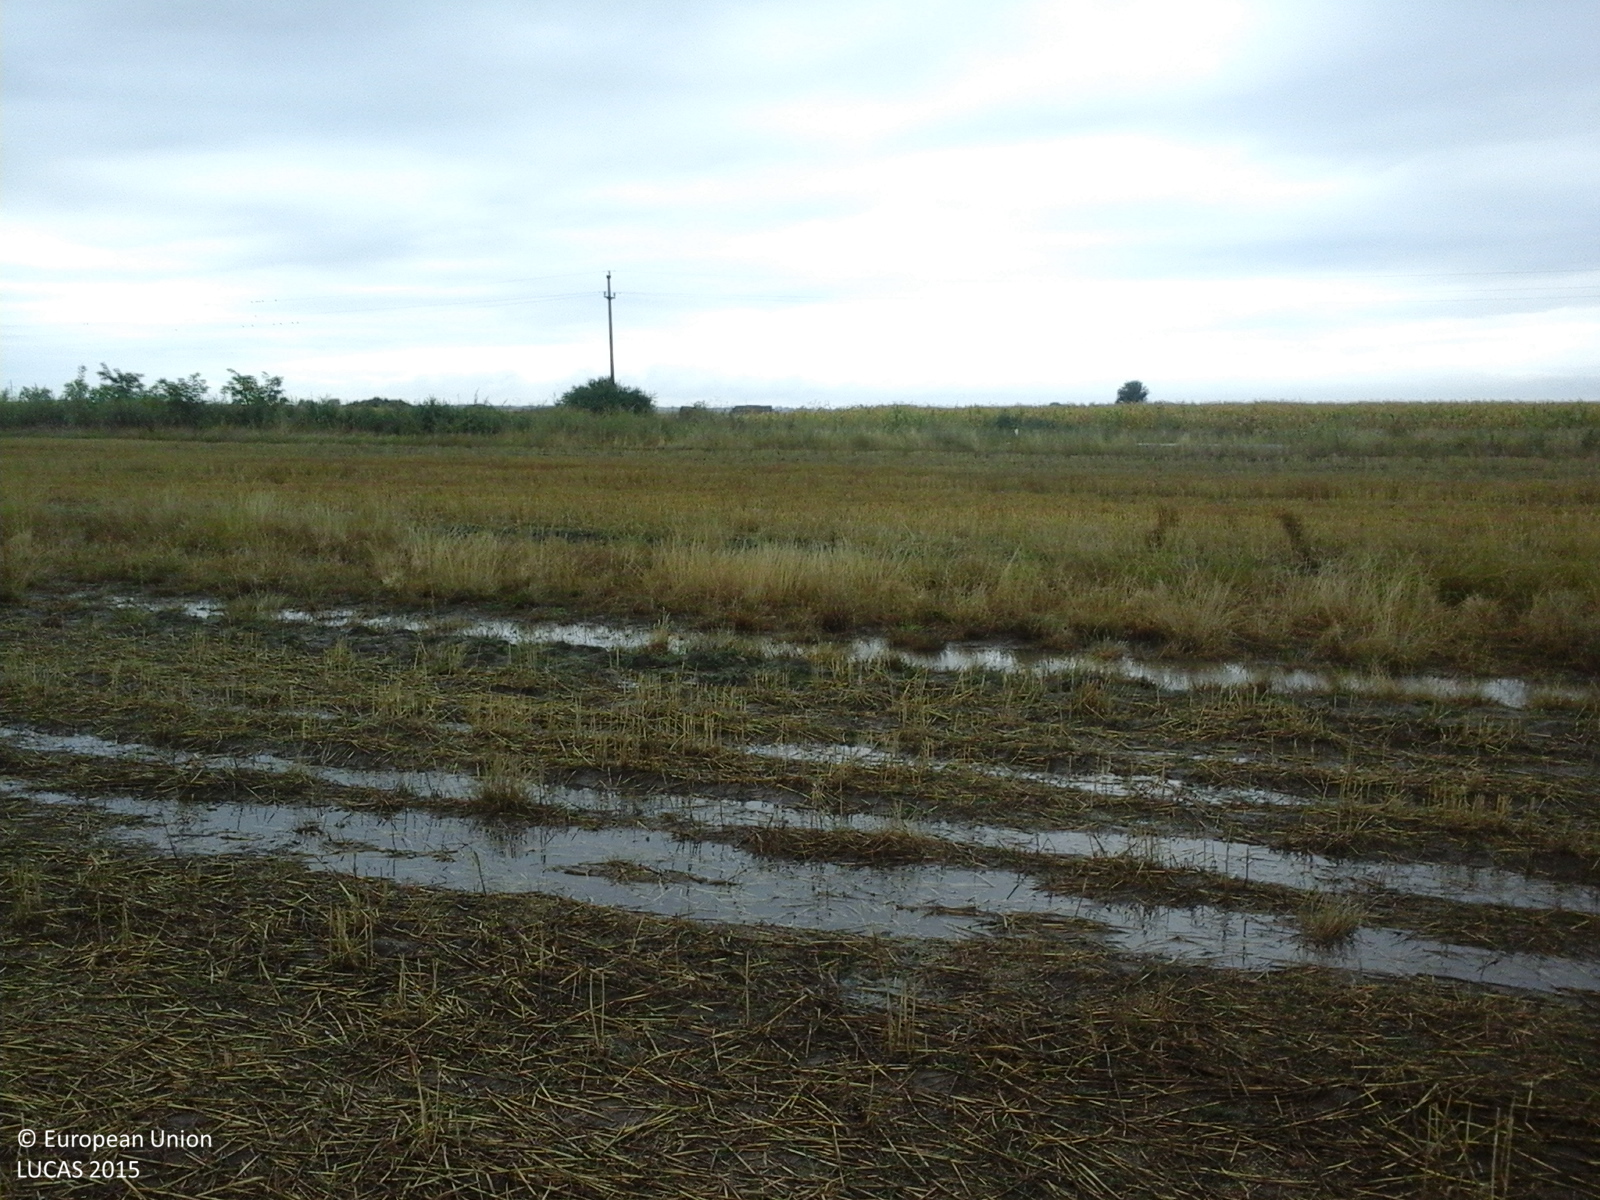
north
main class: Cropland
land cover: Common wheat
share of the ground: 50 - 75 %
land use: Agriculture (excluding fallow land and kitchen gardens)
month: August
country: RO
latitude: 45.5659
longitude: 20.9816
